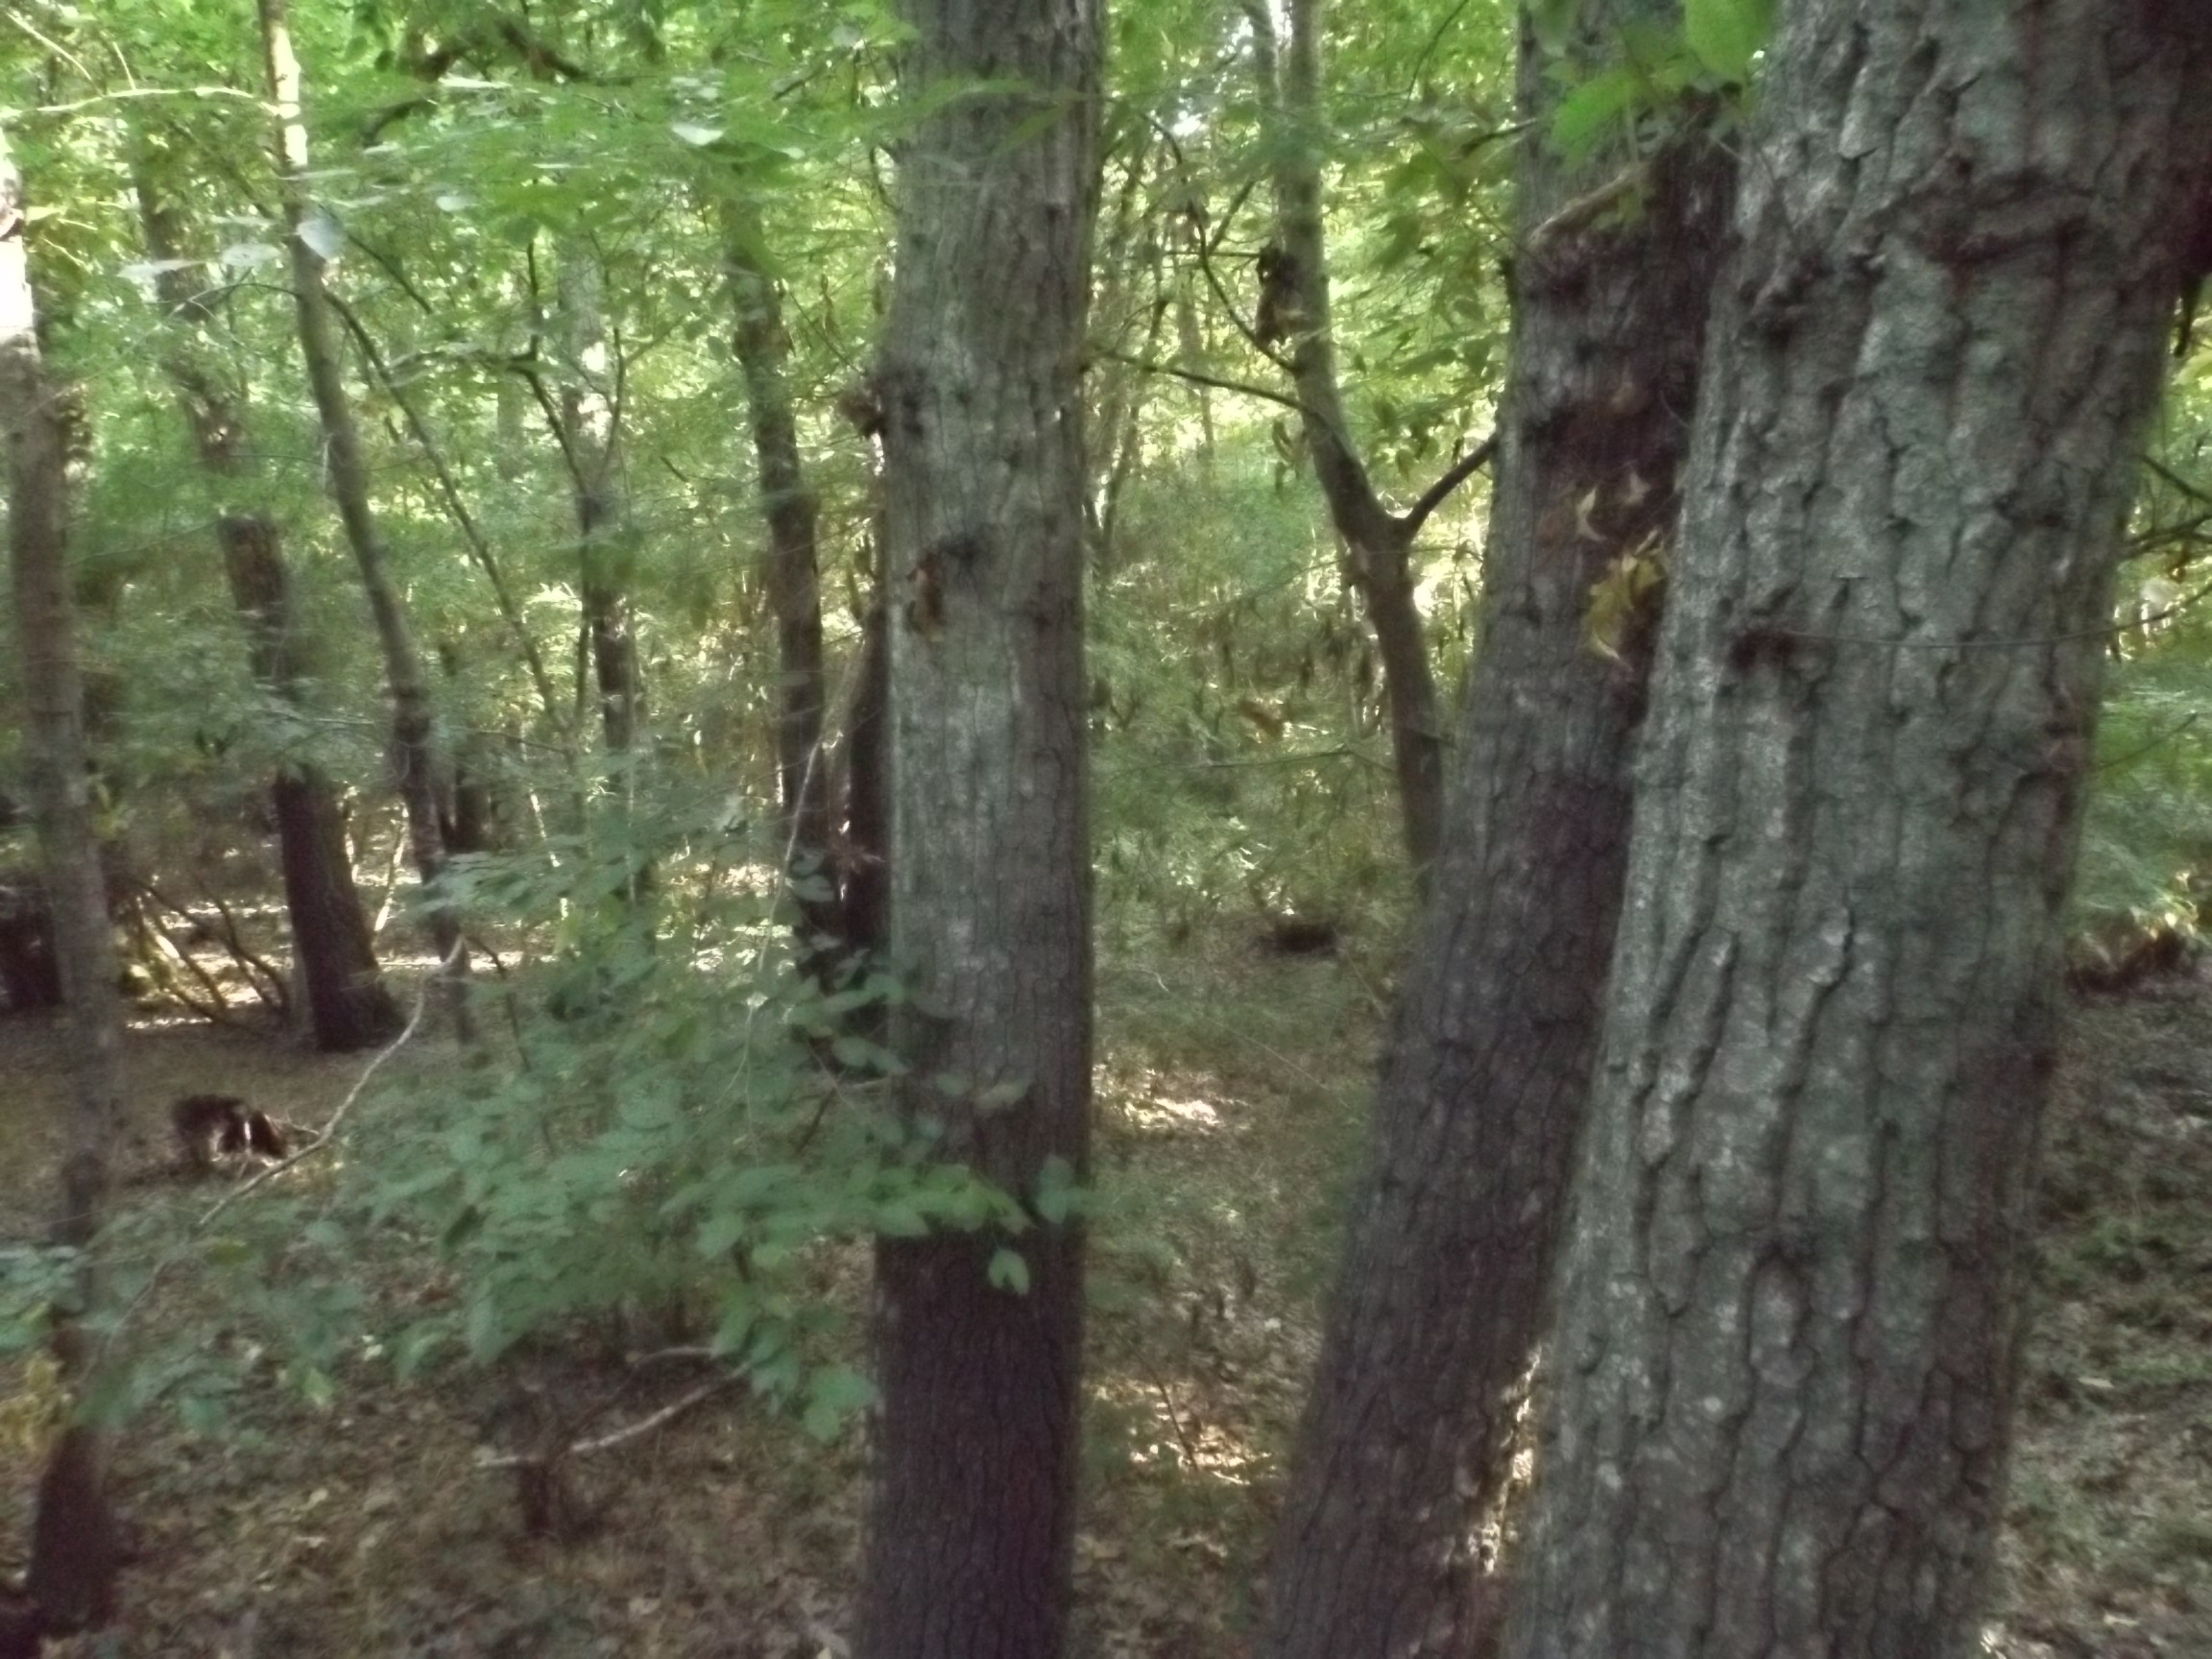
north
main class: Woodland
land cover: Broadleaved woodland
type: mesophytic deciduous forest
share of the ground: > 75 %
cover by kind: broadleaved forest trees 100 %
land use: Forestry
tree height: > 5 m
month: August
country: BG
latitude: 43.3255
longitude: 28.0382
